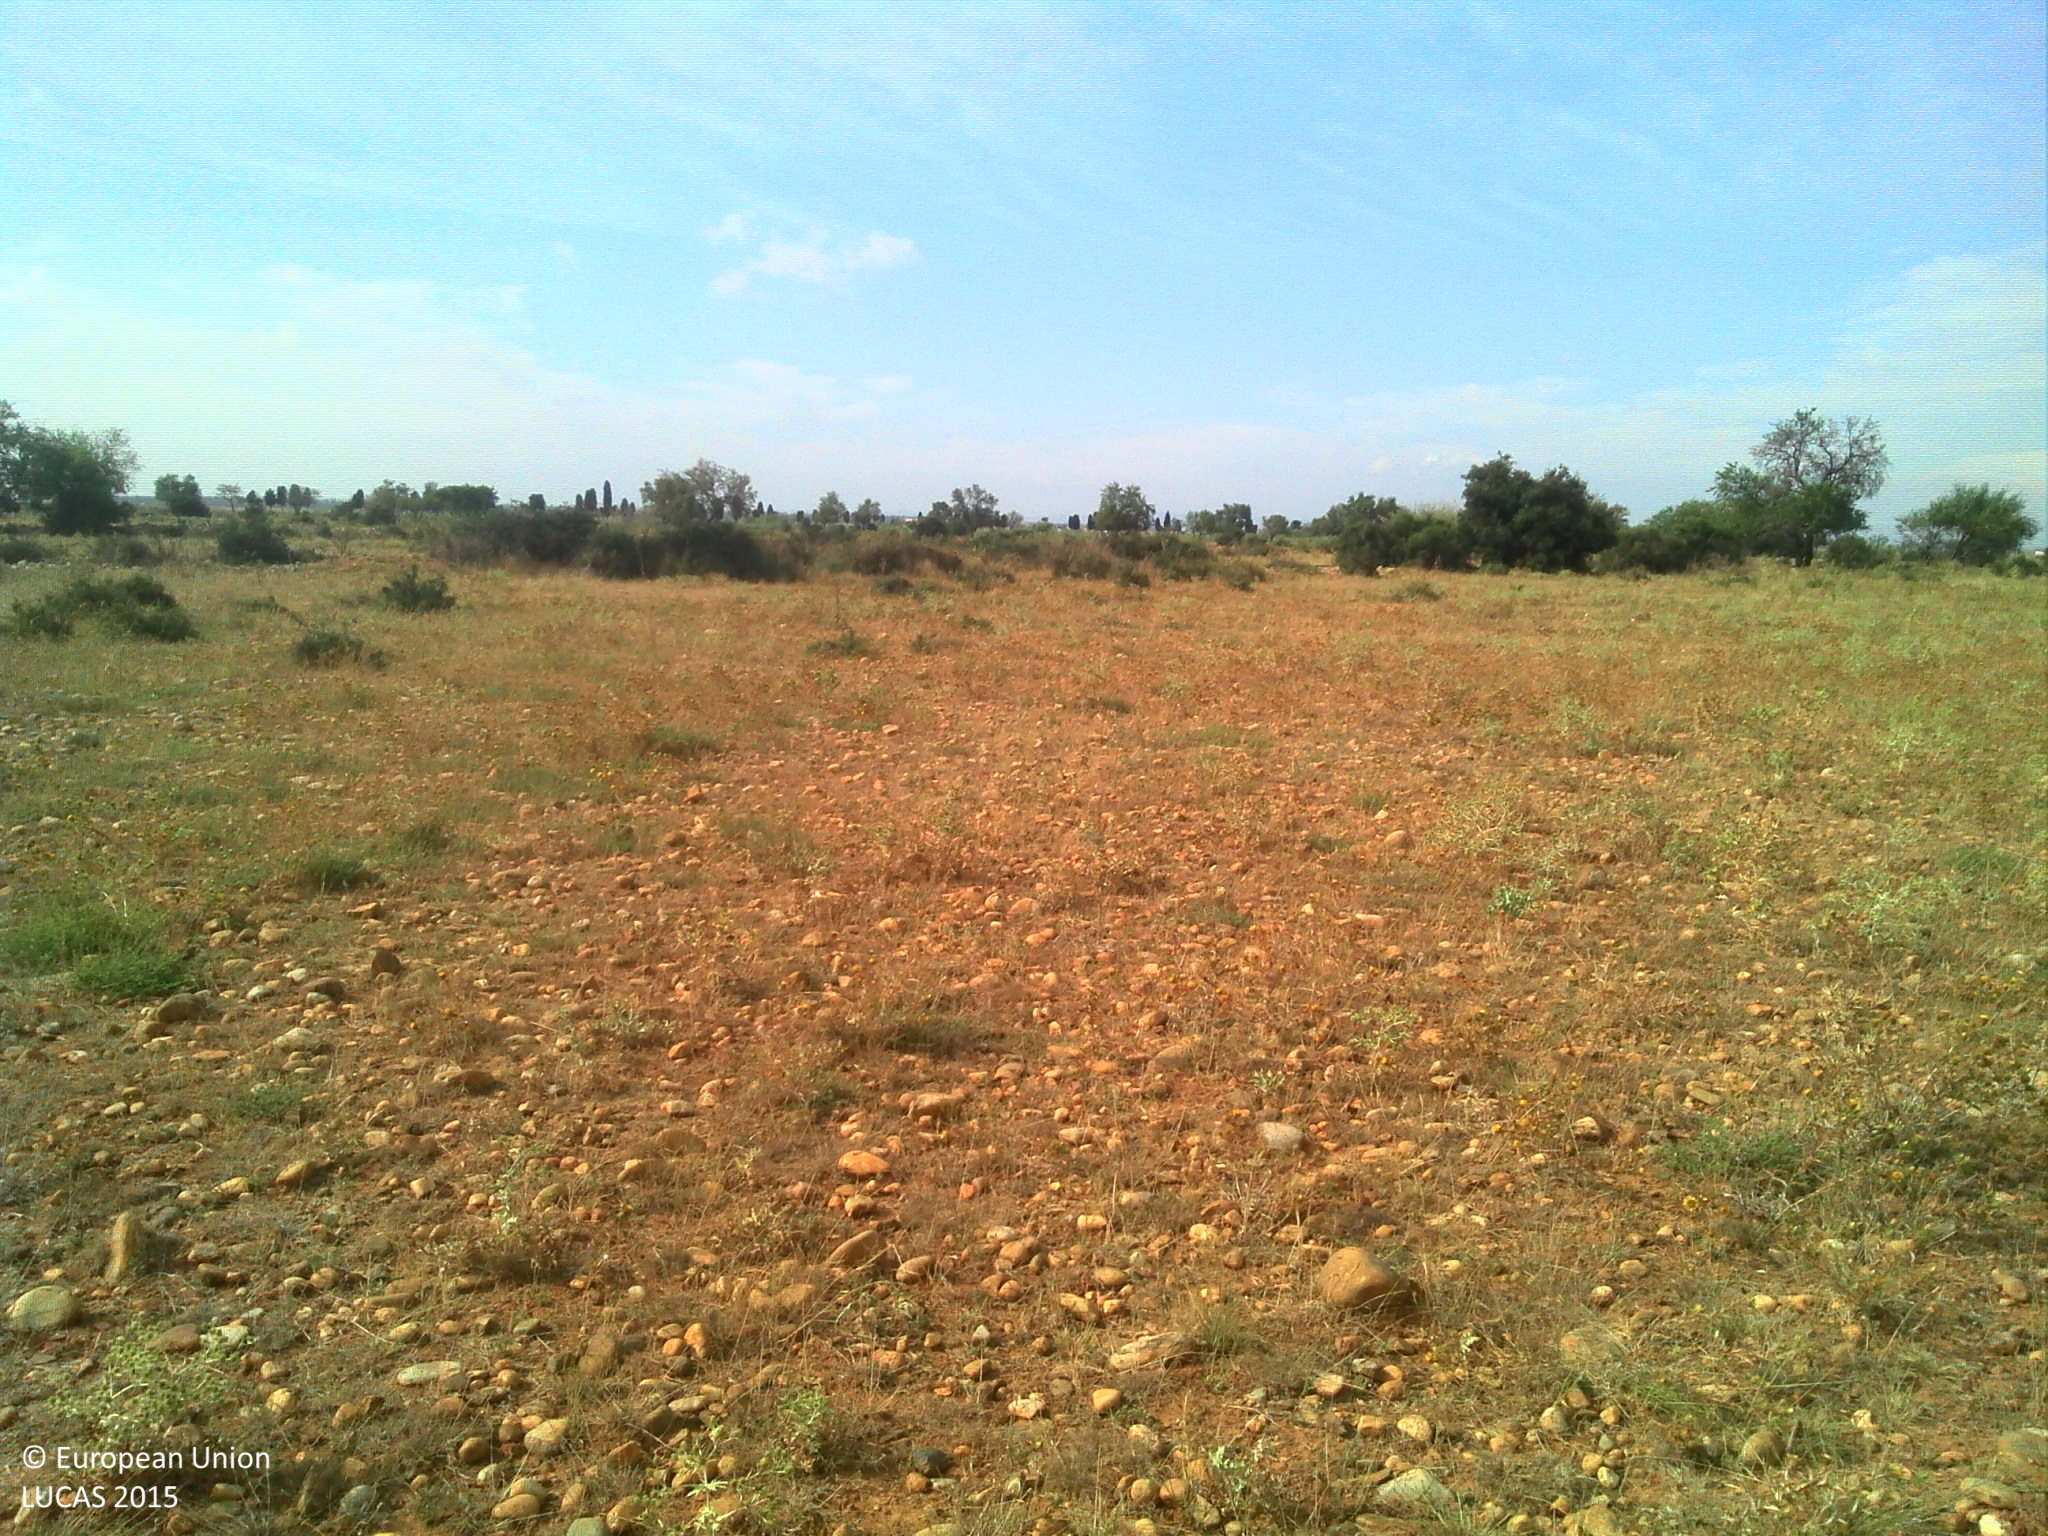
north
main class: Grassland
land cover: Spontaneously vegetated surfaces
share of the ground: 25 - 50 %
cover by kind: unconsolidated bare surface 60 %, herbaceous plants 35 %, shrubs 5 %
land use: Agriculture (excluding fallow land and kitchen gardens)
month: July
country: FR
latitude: 43.4998
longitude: 4.8528
